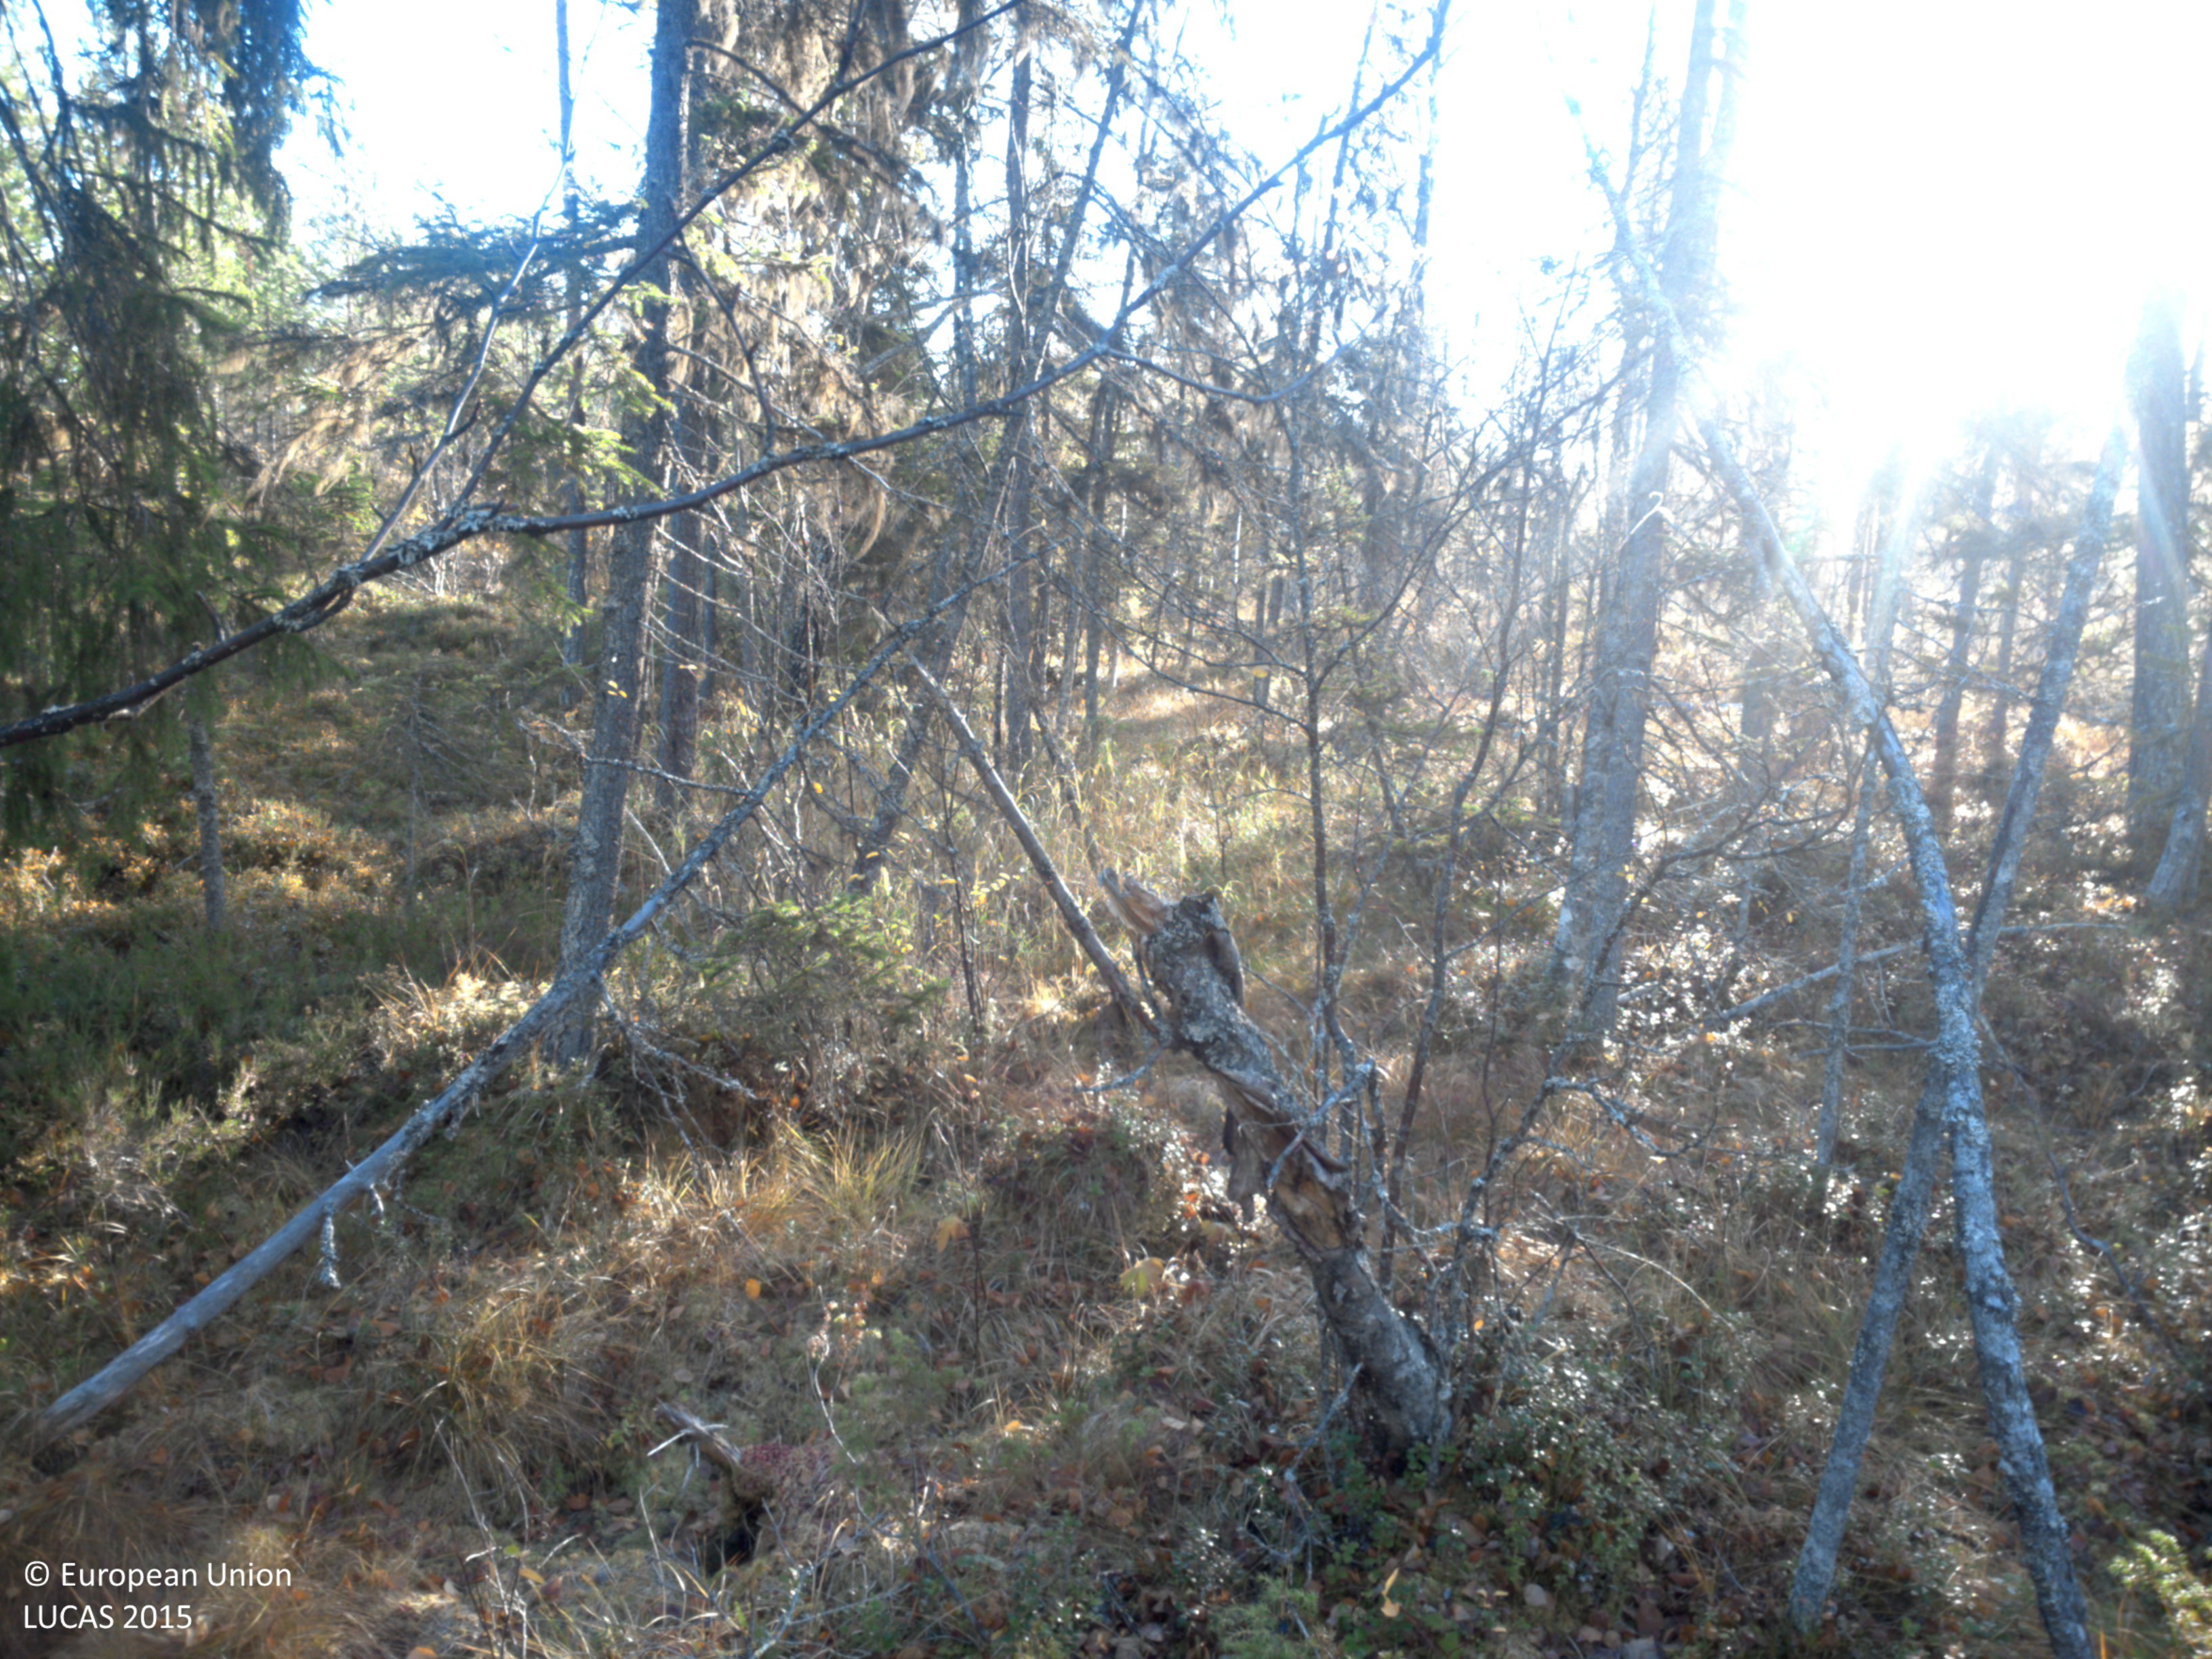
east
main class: Woodland
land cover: Spruce dominated mixed woodland
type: boreal forest
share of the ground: 50 - 75 %
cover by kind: coniferous forest trees 35 %, broadleaved forest trees 25 %, shrubs 20 %, herbaceous plants 10 %, lichens and mosses 10 %
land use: Forestry
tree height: > 5 m
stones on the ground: < 10 %
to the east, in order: Spruce dominated mixed woodland; Pine dominated coniferous woodland; Spruce dominated mixed woodland; Pine dominated mixed woodland; Spruce dominated coniferous woodland
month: October
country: SE
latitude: 64.7353
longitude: 18.4711
